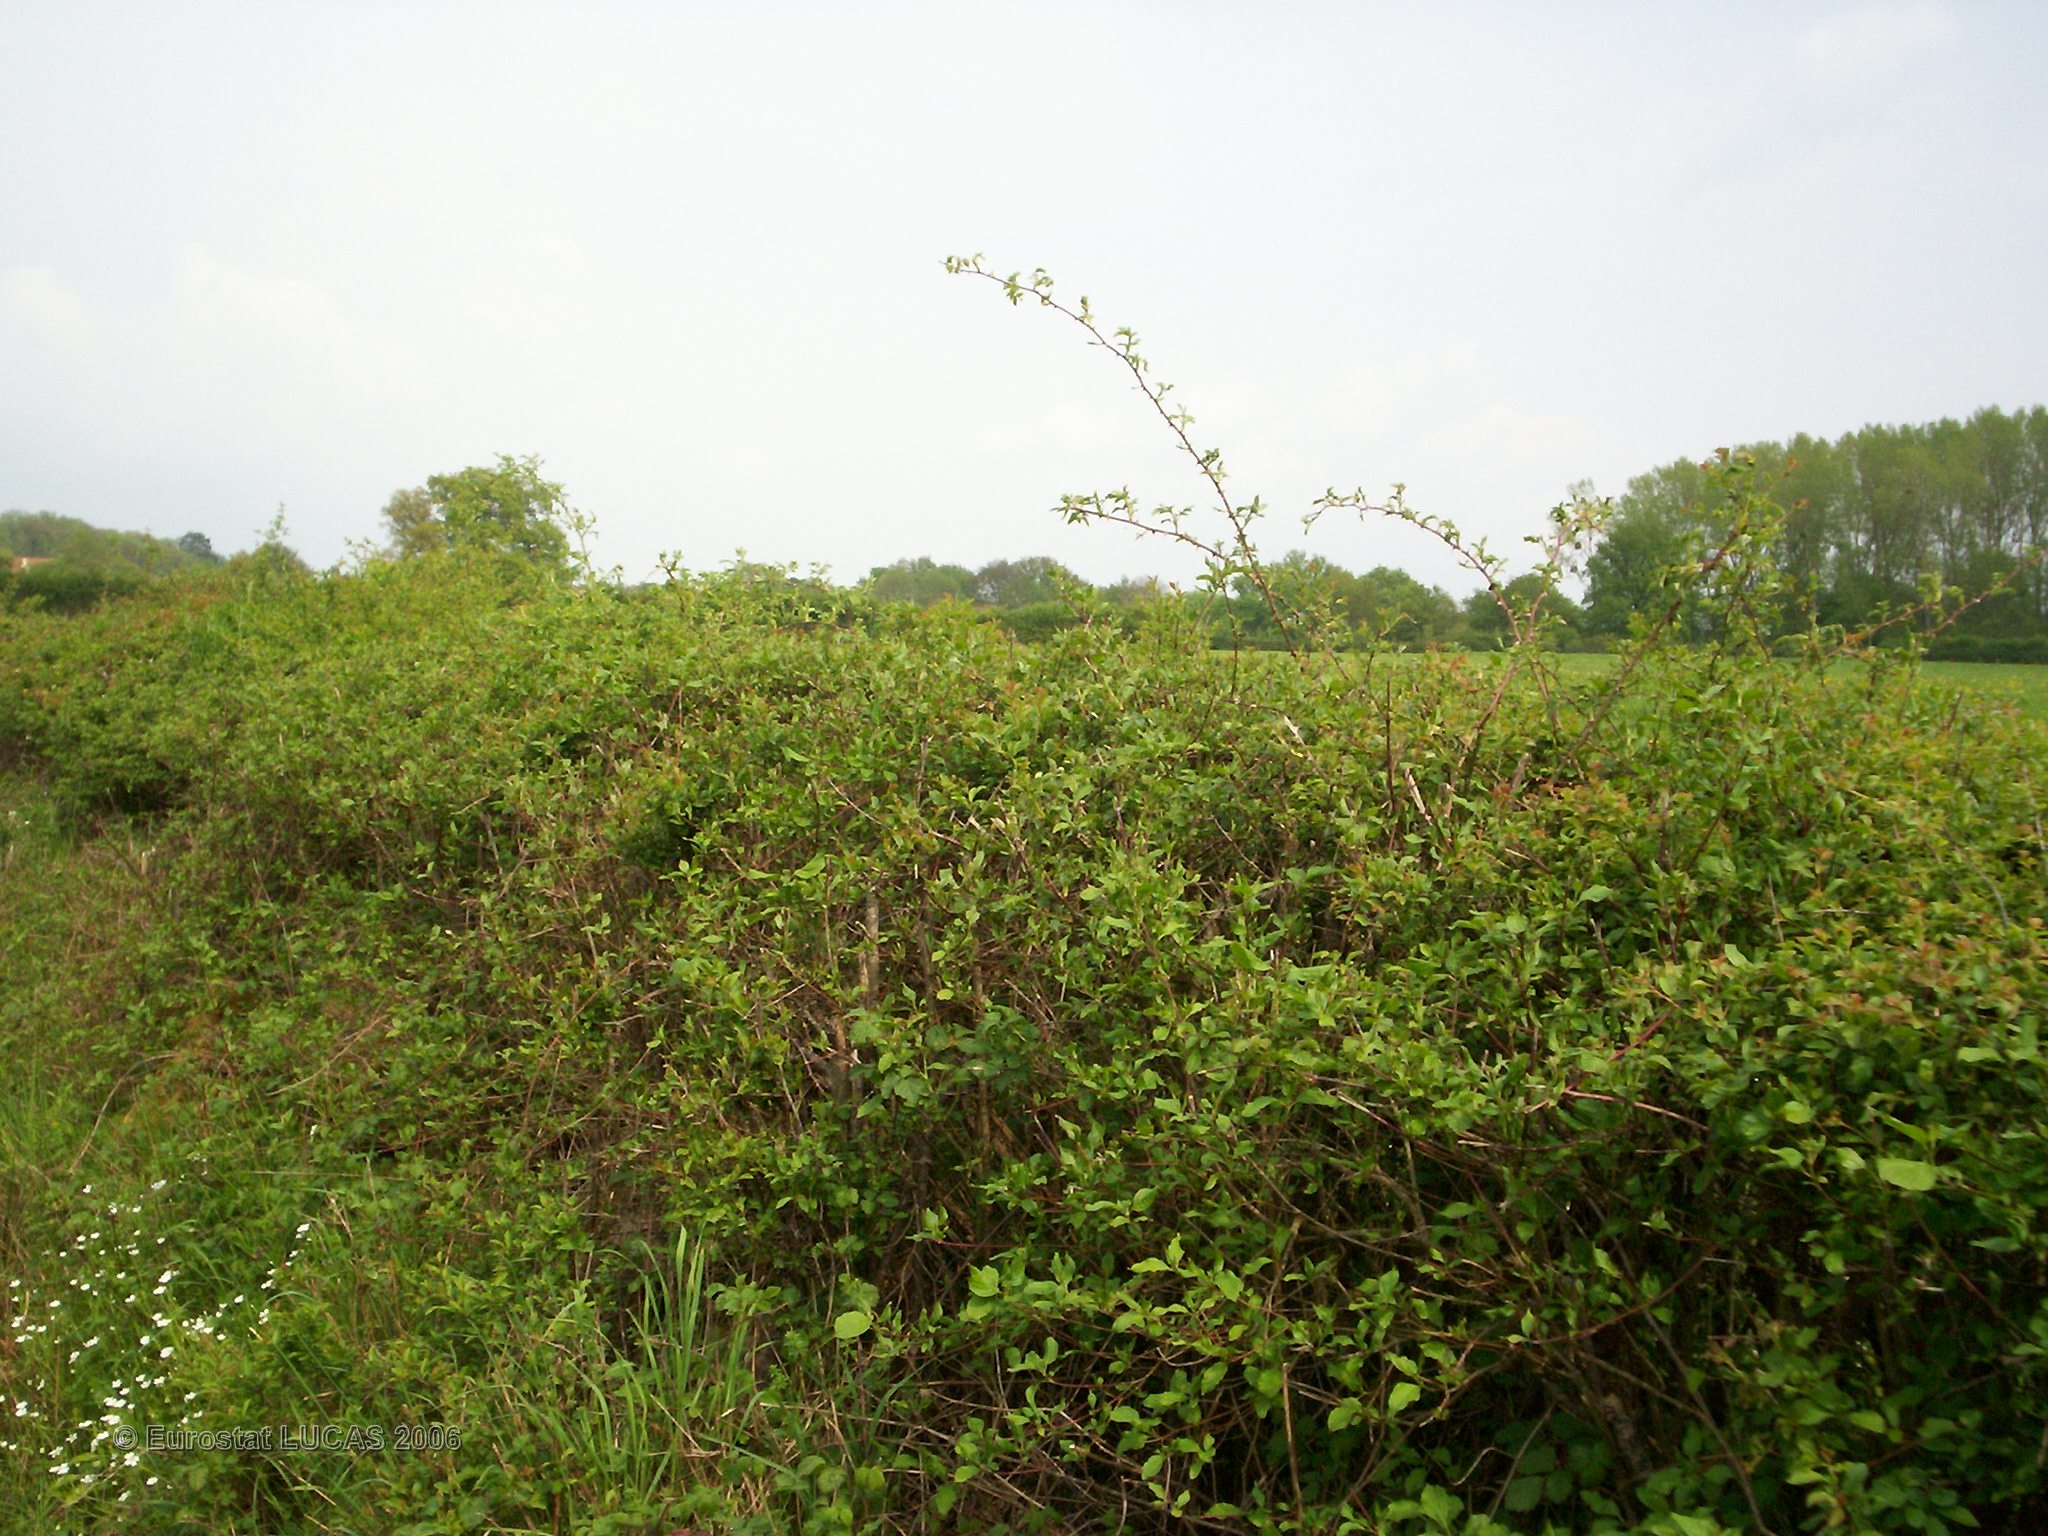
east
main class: Grassland
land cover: Grassland without tree/shrub cover
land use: Agriculture (excluding fallow land and kitchen gardens)
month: May
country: FR
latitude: 47.4939
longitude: 3.8783
